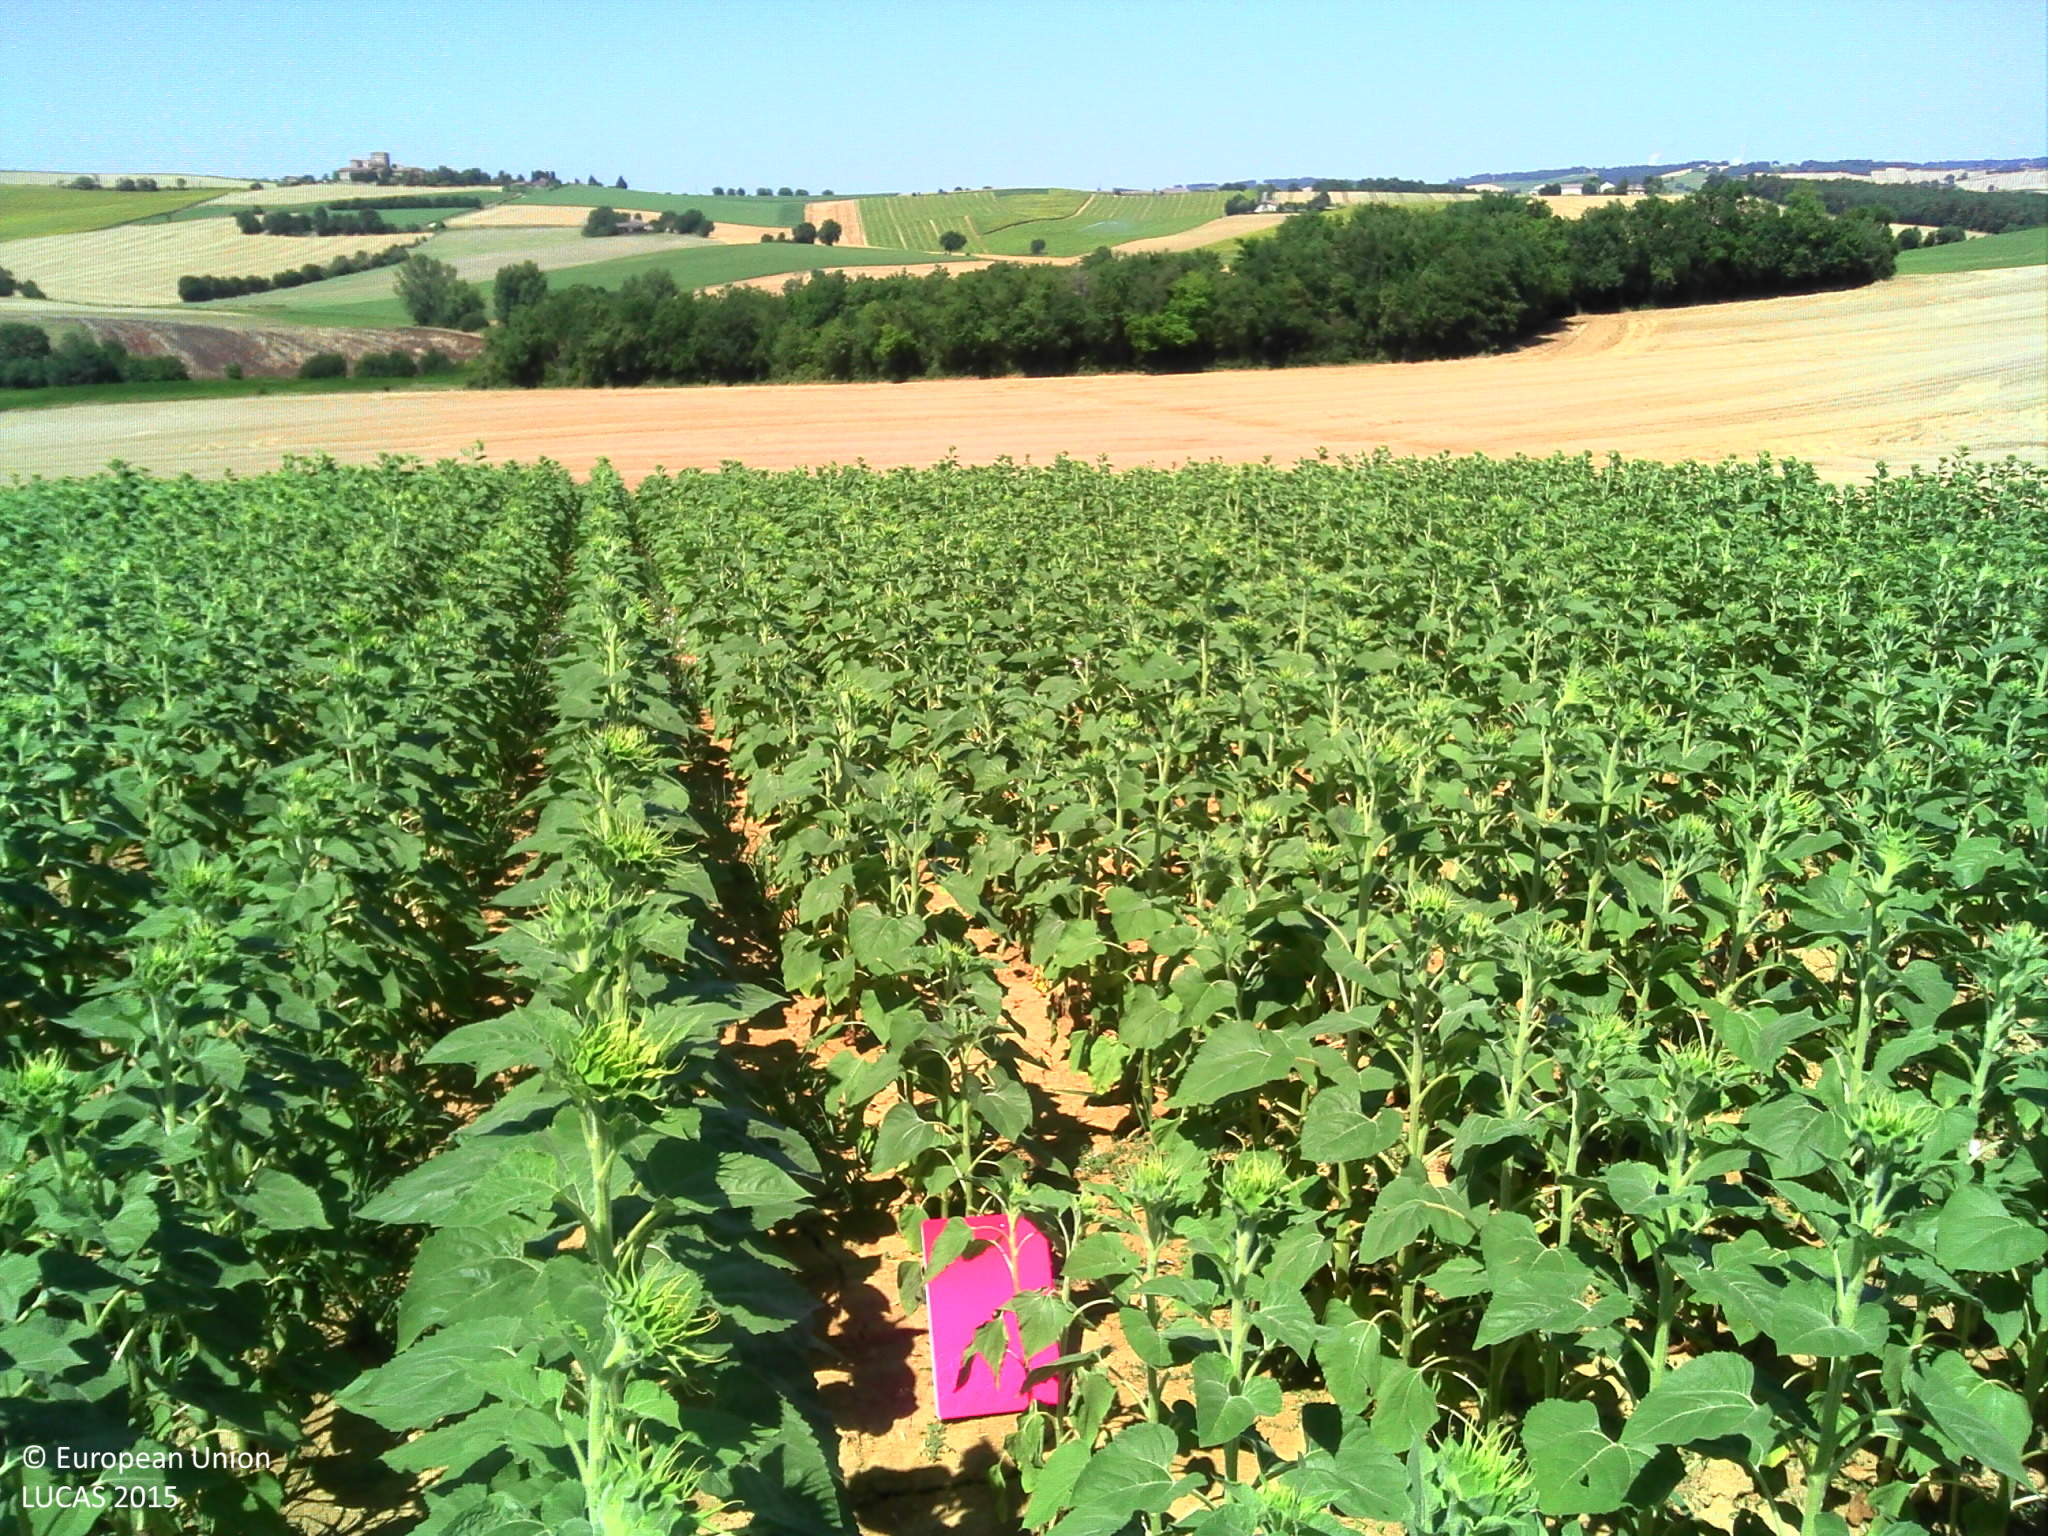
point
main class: Cropland
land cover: Sunflower
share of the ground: > 75 %
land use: Agriculture (excluding fallow land and kitchen gardens)
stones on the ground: < 10 %
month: July
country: FR
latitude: 44.0051
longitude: 0.7047
